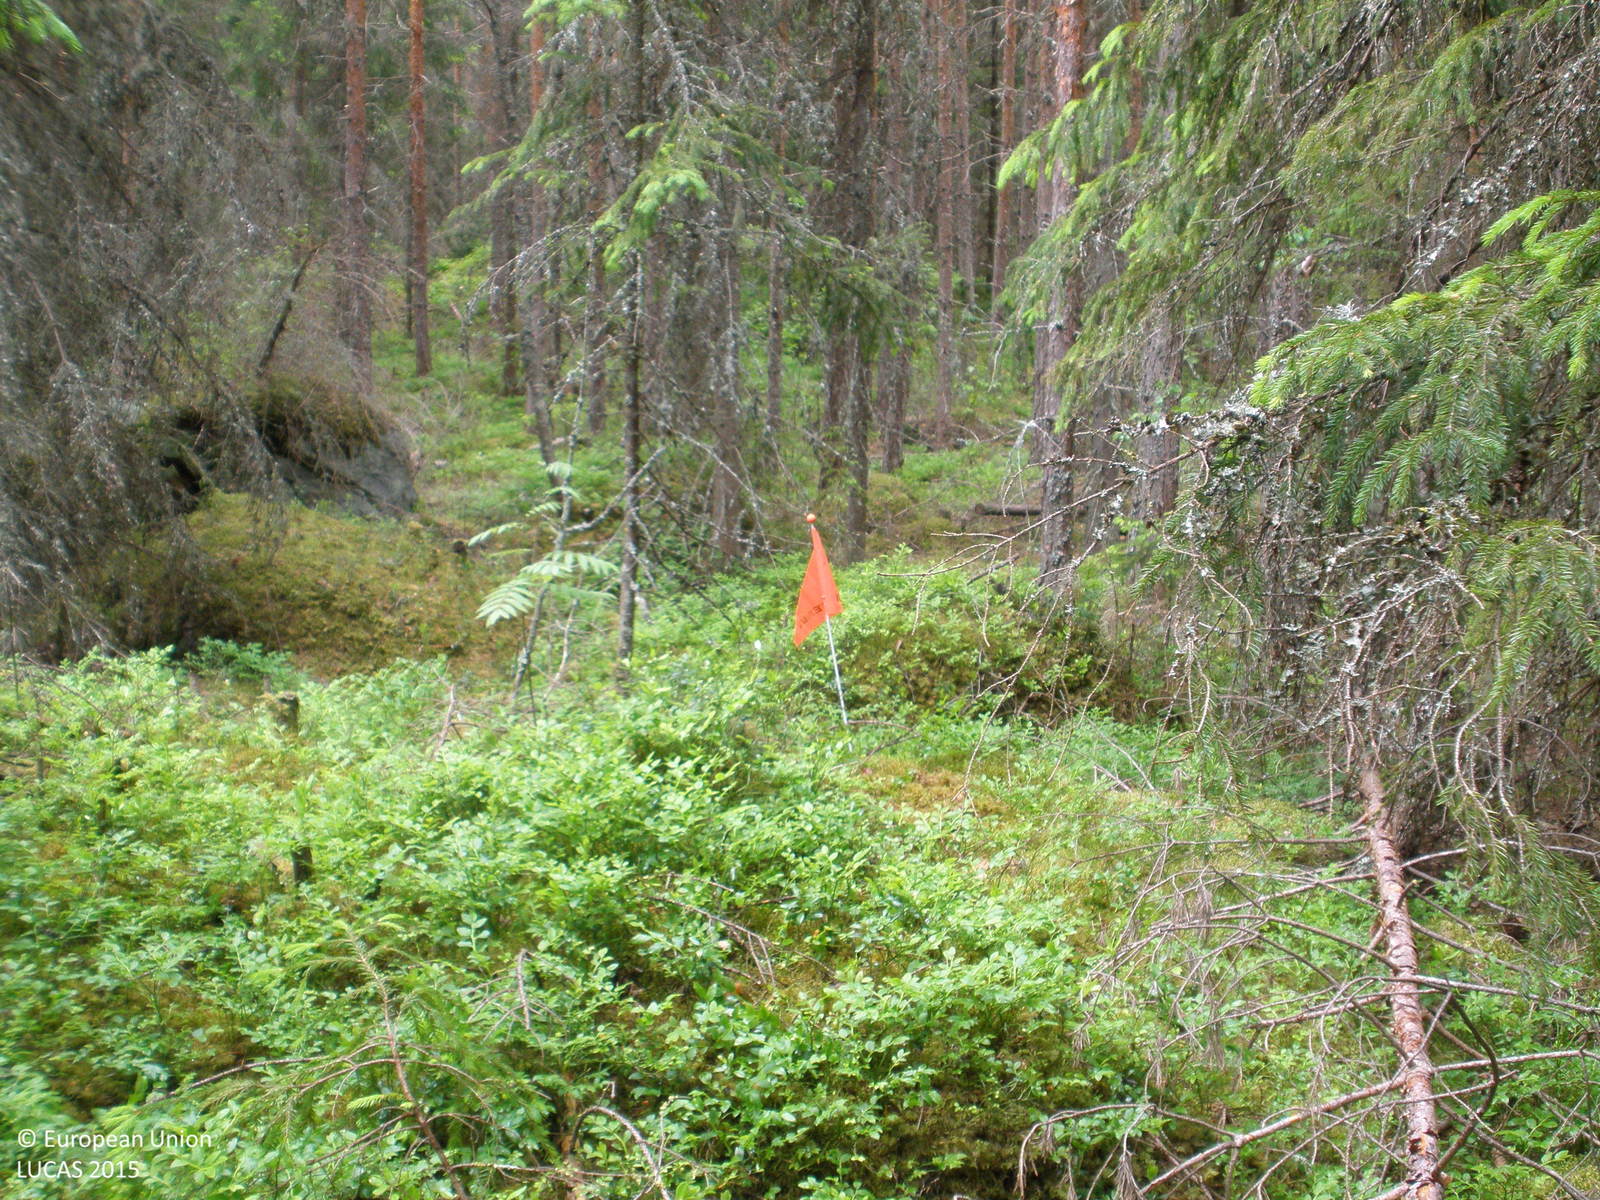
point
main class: Woodland
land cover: Spruce dominated coniferous woodland
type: boreal forest
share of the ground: > 75 %
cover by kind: coniferous forest trees 85 %, lichens and mosses 10 %, broadleaved forest trees 5 %
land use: Forestry
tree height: > 5 m
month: June
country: FI
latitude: 61.3308
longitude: 24.5447
